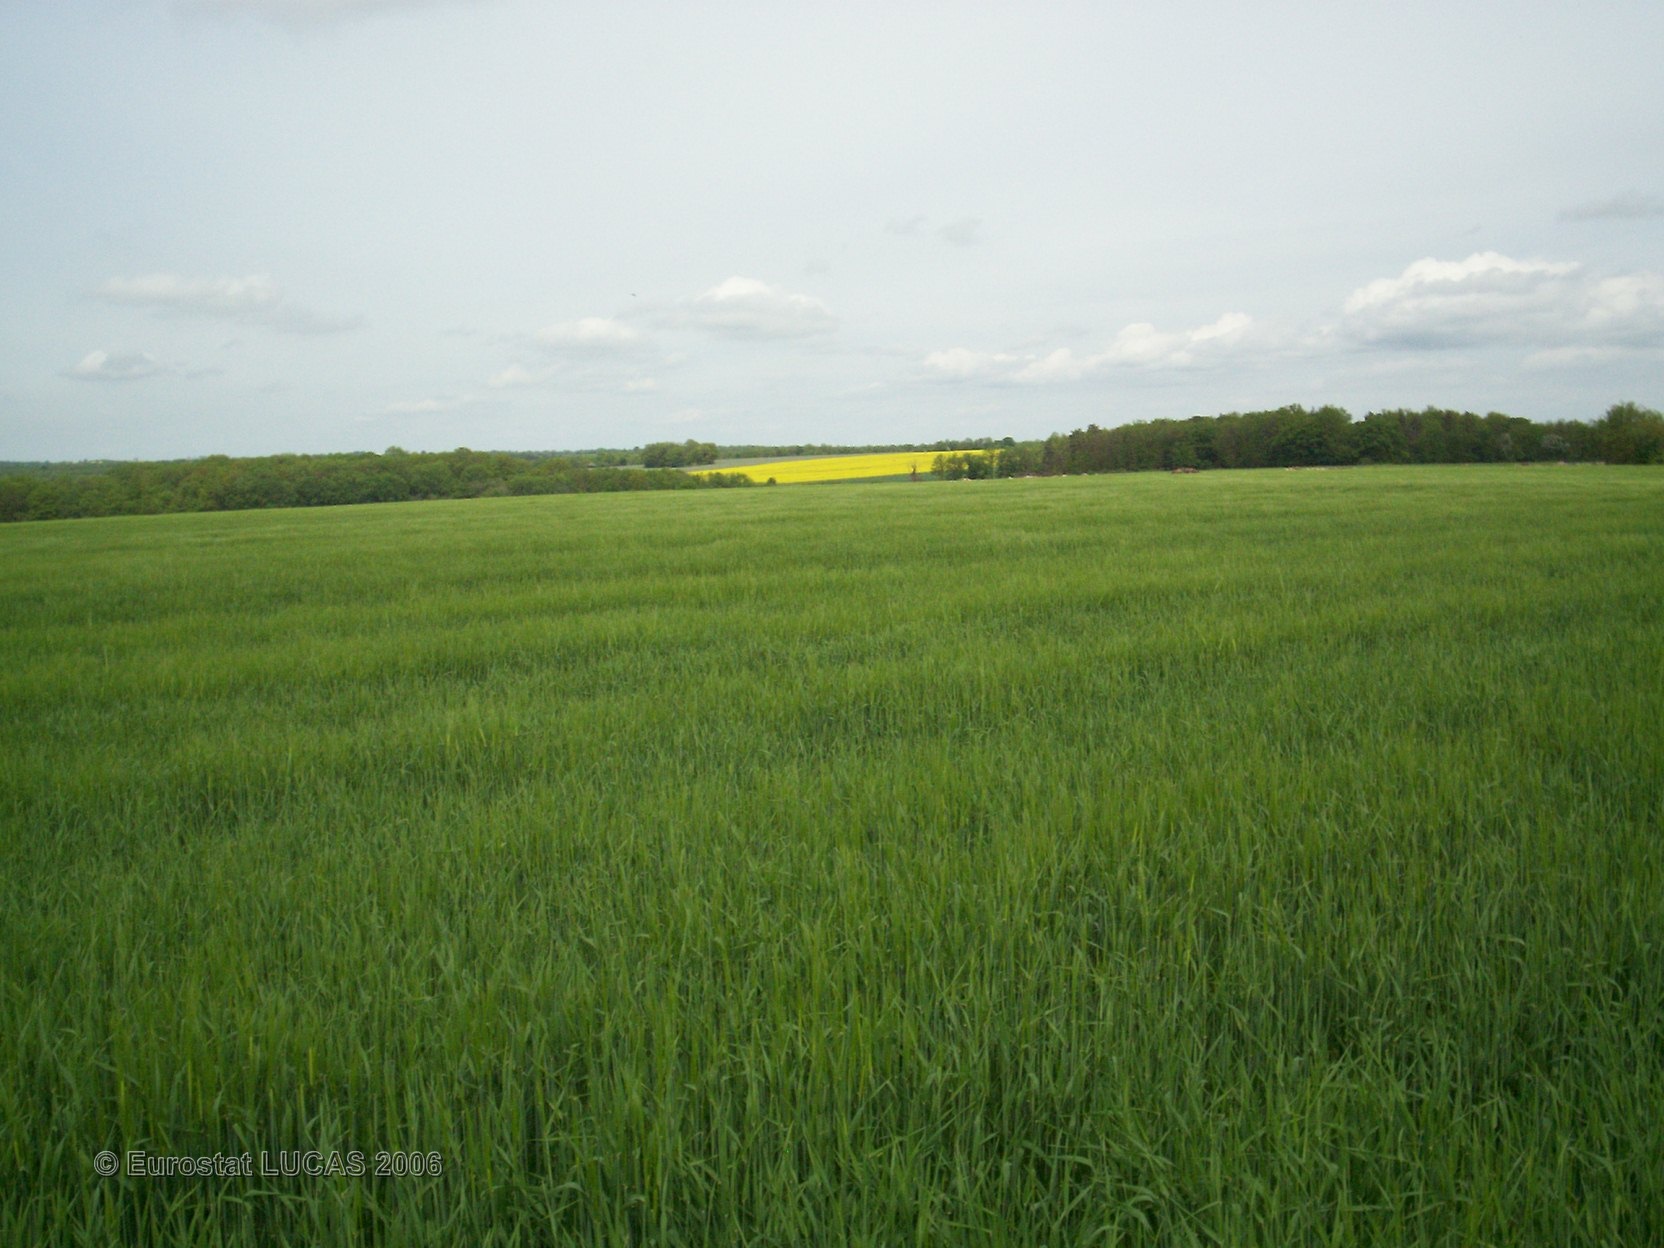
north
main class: Cropland
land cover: Barley
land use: Agriculture (excluding fallow land and kitchen gardens)
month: May
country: FR
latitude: 47.3317
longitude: 4.5608
